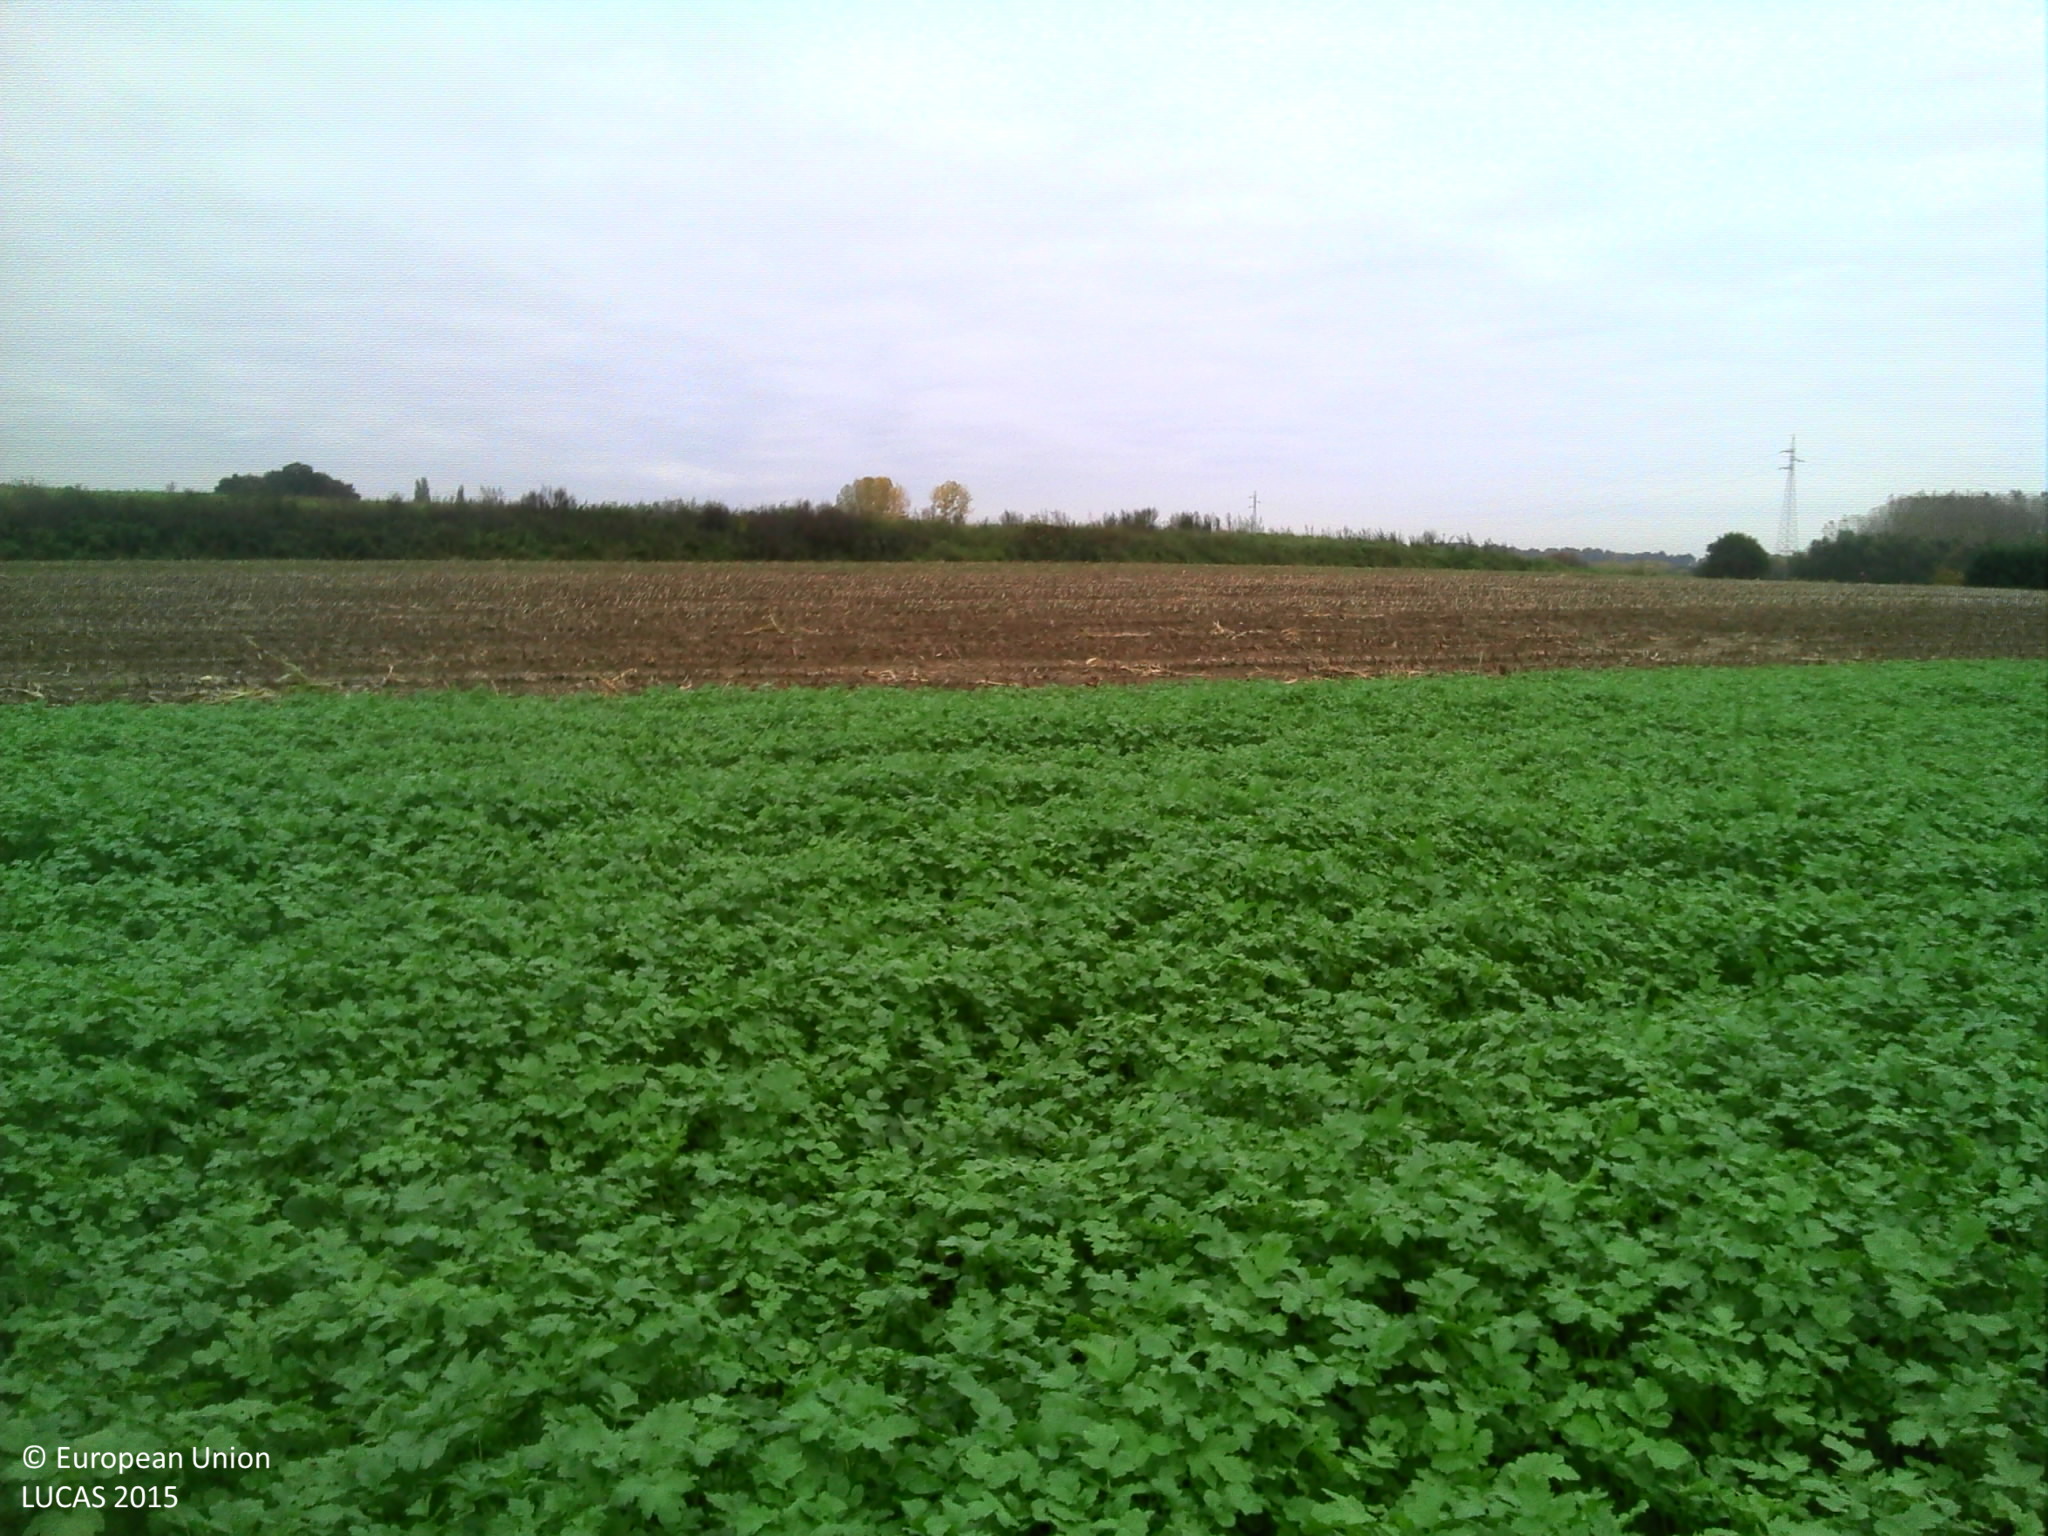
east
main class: Cropland
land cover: Other fibre and oleaginous crops
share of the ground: > 75 %
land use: Agriculture (excluding fallow land and kitchen gardens)
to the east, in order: Other fibre and oleaginous crops; Maize; Spontaneously vegetated surfaces; Tracks; Sugar beet; Maize
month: October
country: BE
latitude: 50.8980
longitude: 4.1223
